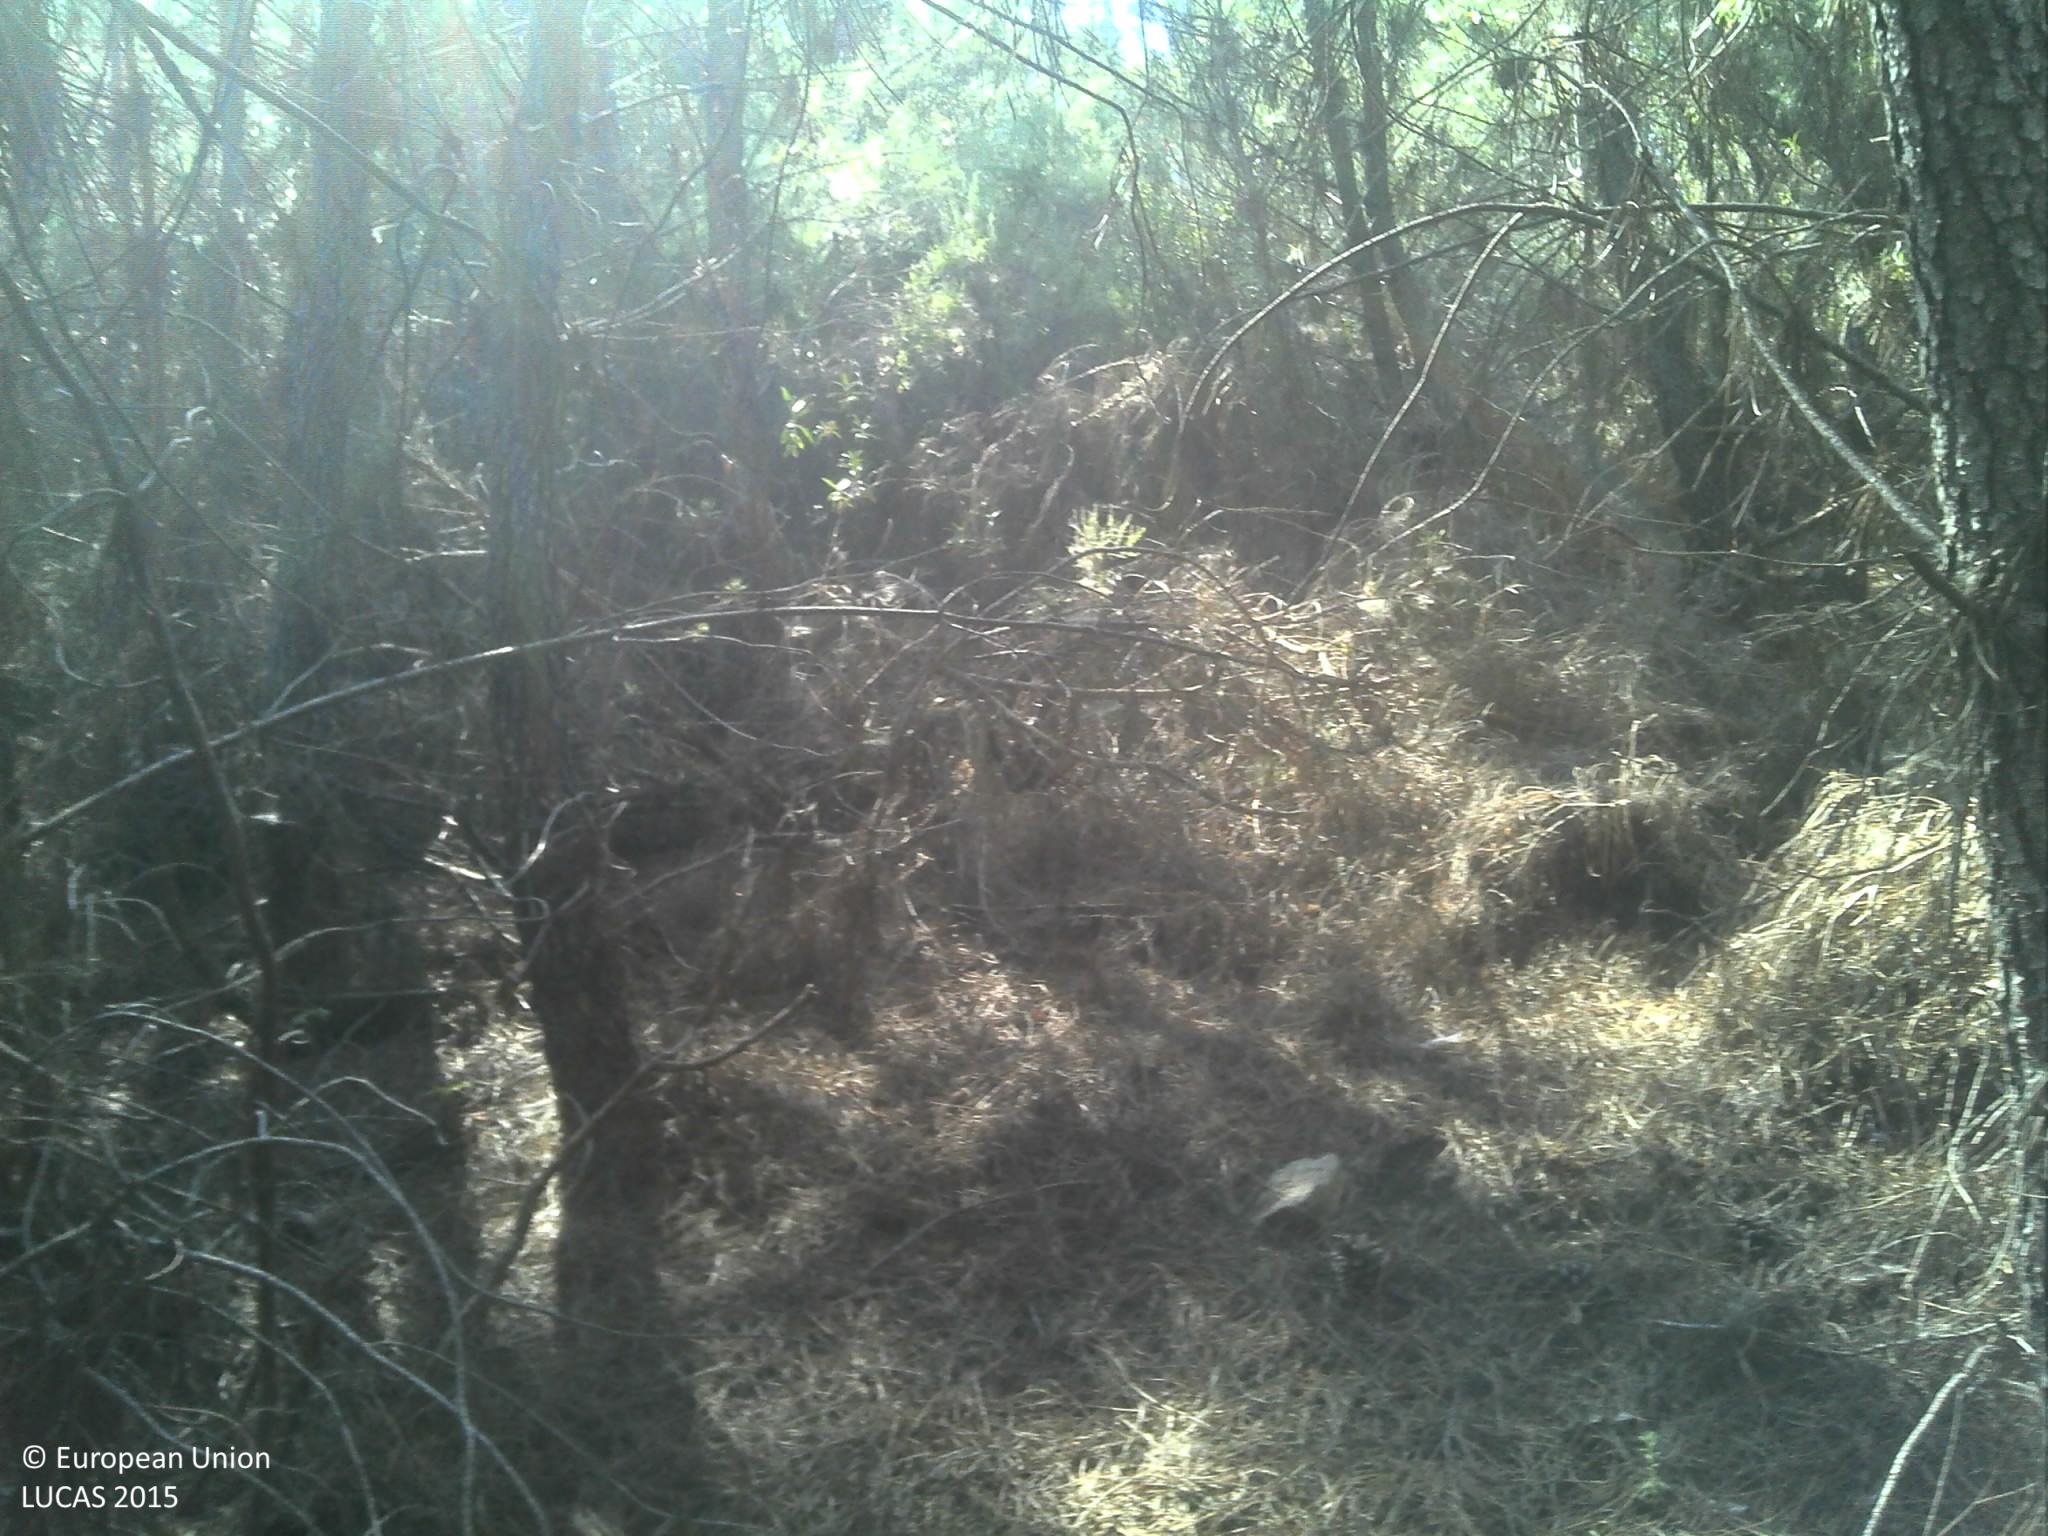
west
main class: Woodland
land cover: Pine dominated coniferous woodland
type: coniferous forest of the mediterranean region
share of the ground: > 75 %
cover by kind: coniferous forest trees 75 %, shrubs 15 %, unconsolidated bare surface 5 %
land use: Forestry
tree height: > 5 m
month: June
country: PT
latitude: 40.2987
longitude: -7.1218
